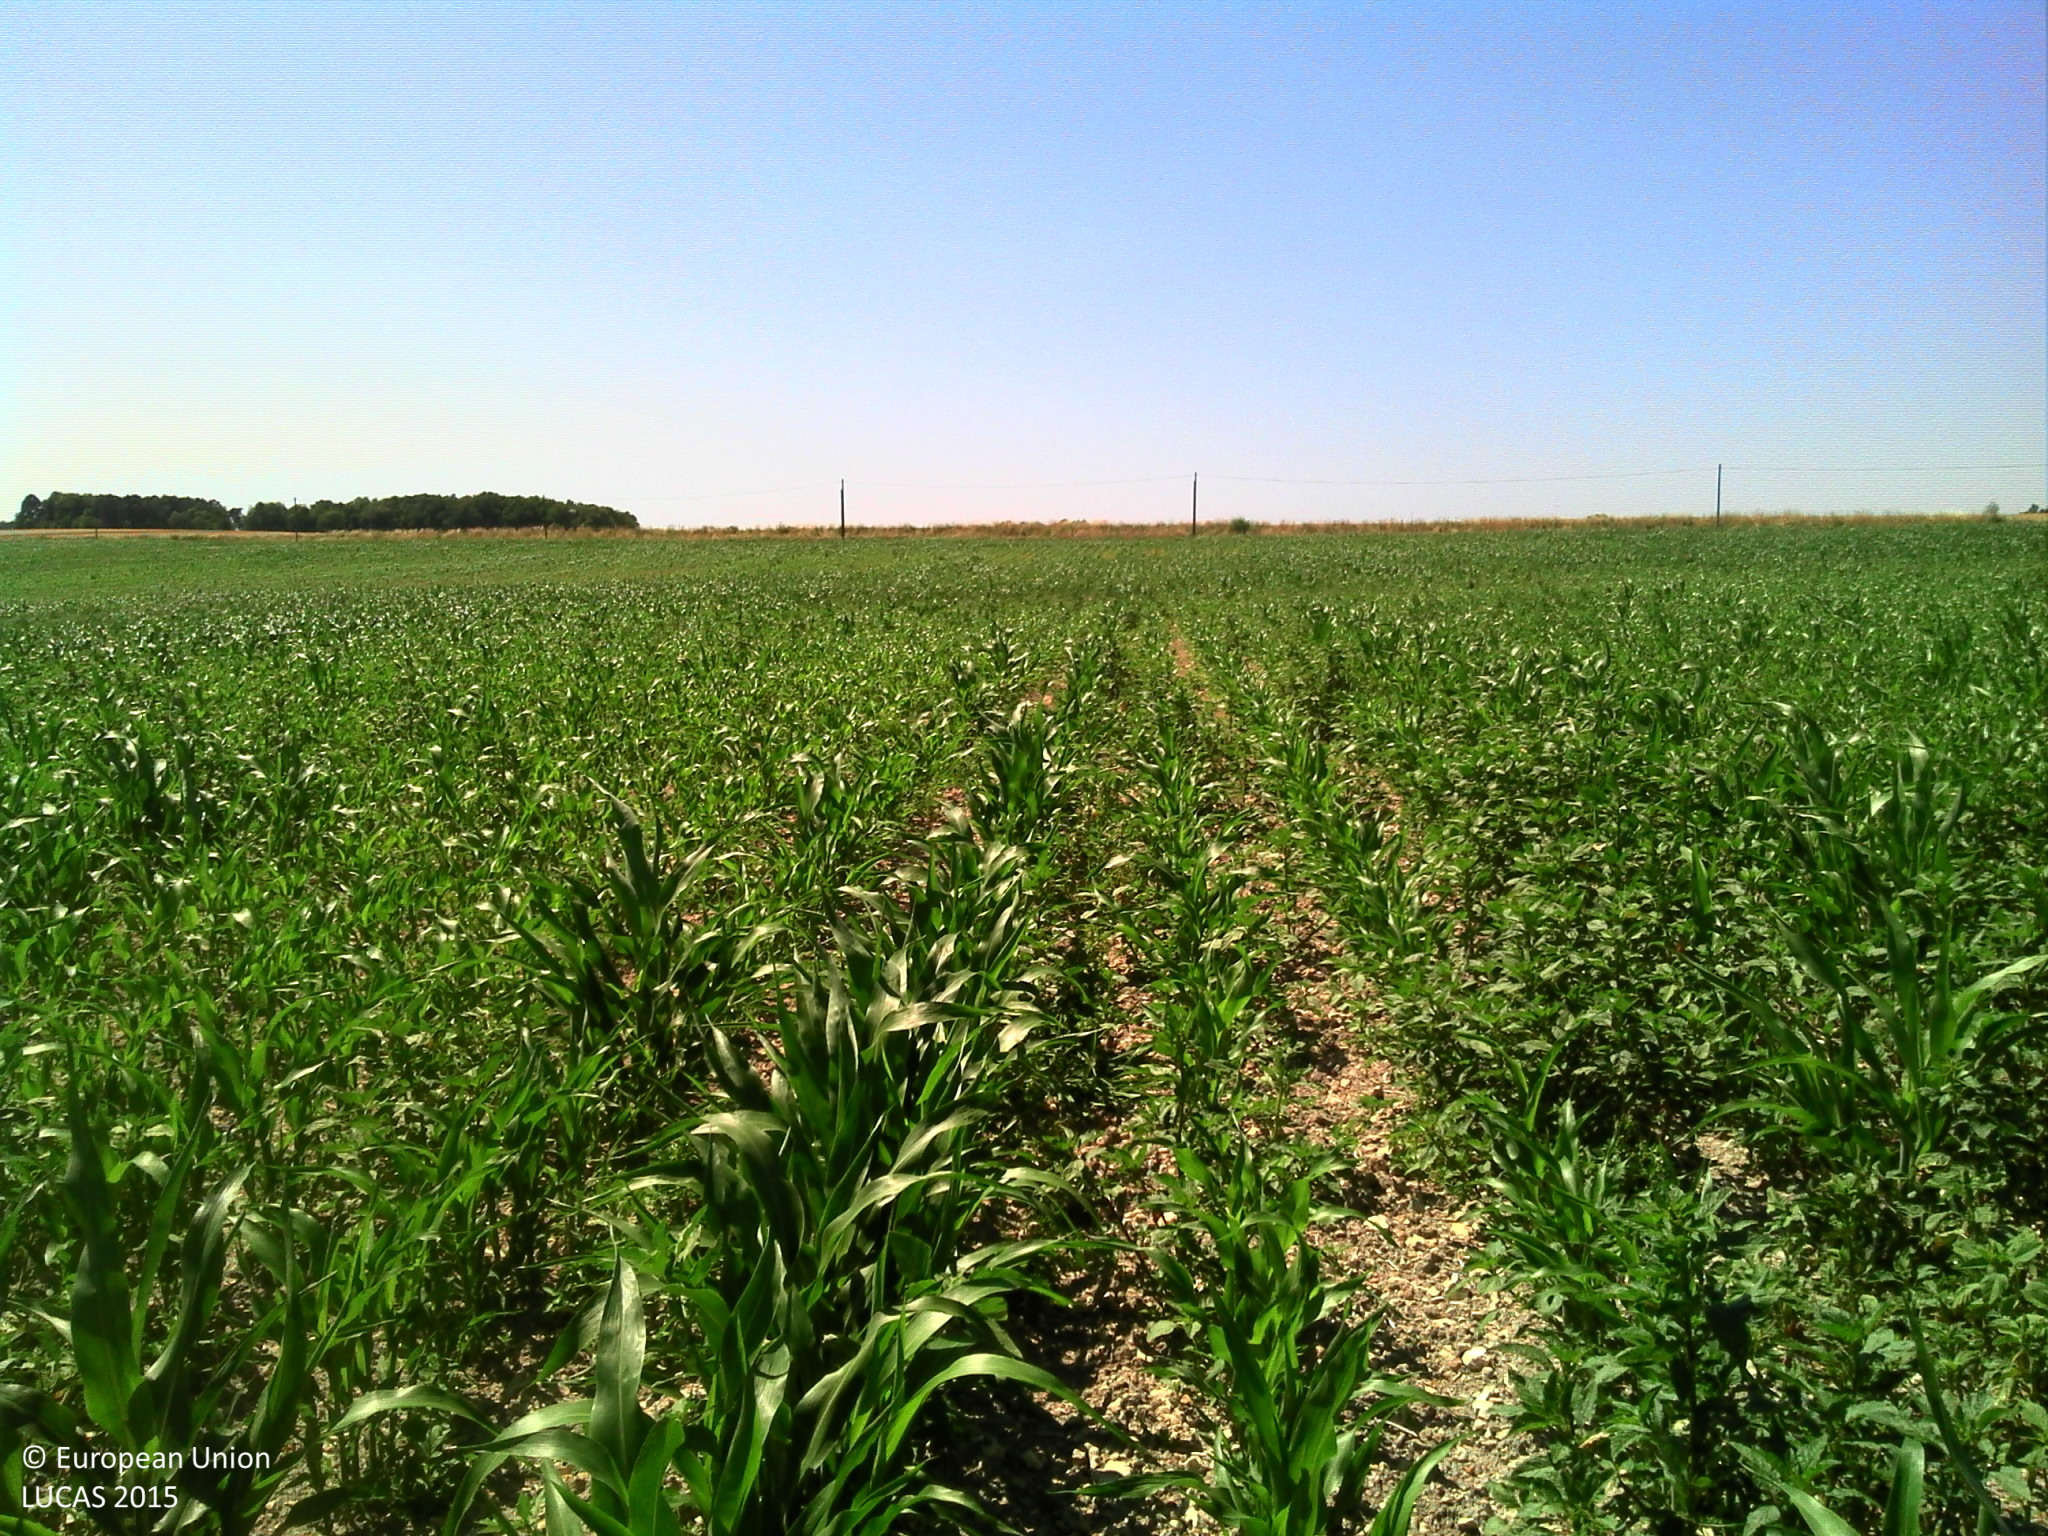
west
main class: Cropland
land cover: Maize
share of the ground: 25 - 50 %
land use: Agriculture (excluding fallow land and kitchen gardens)
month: July
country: FR
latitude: 47.2357
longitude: 0.5353
